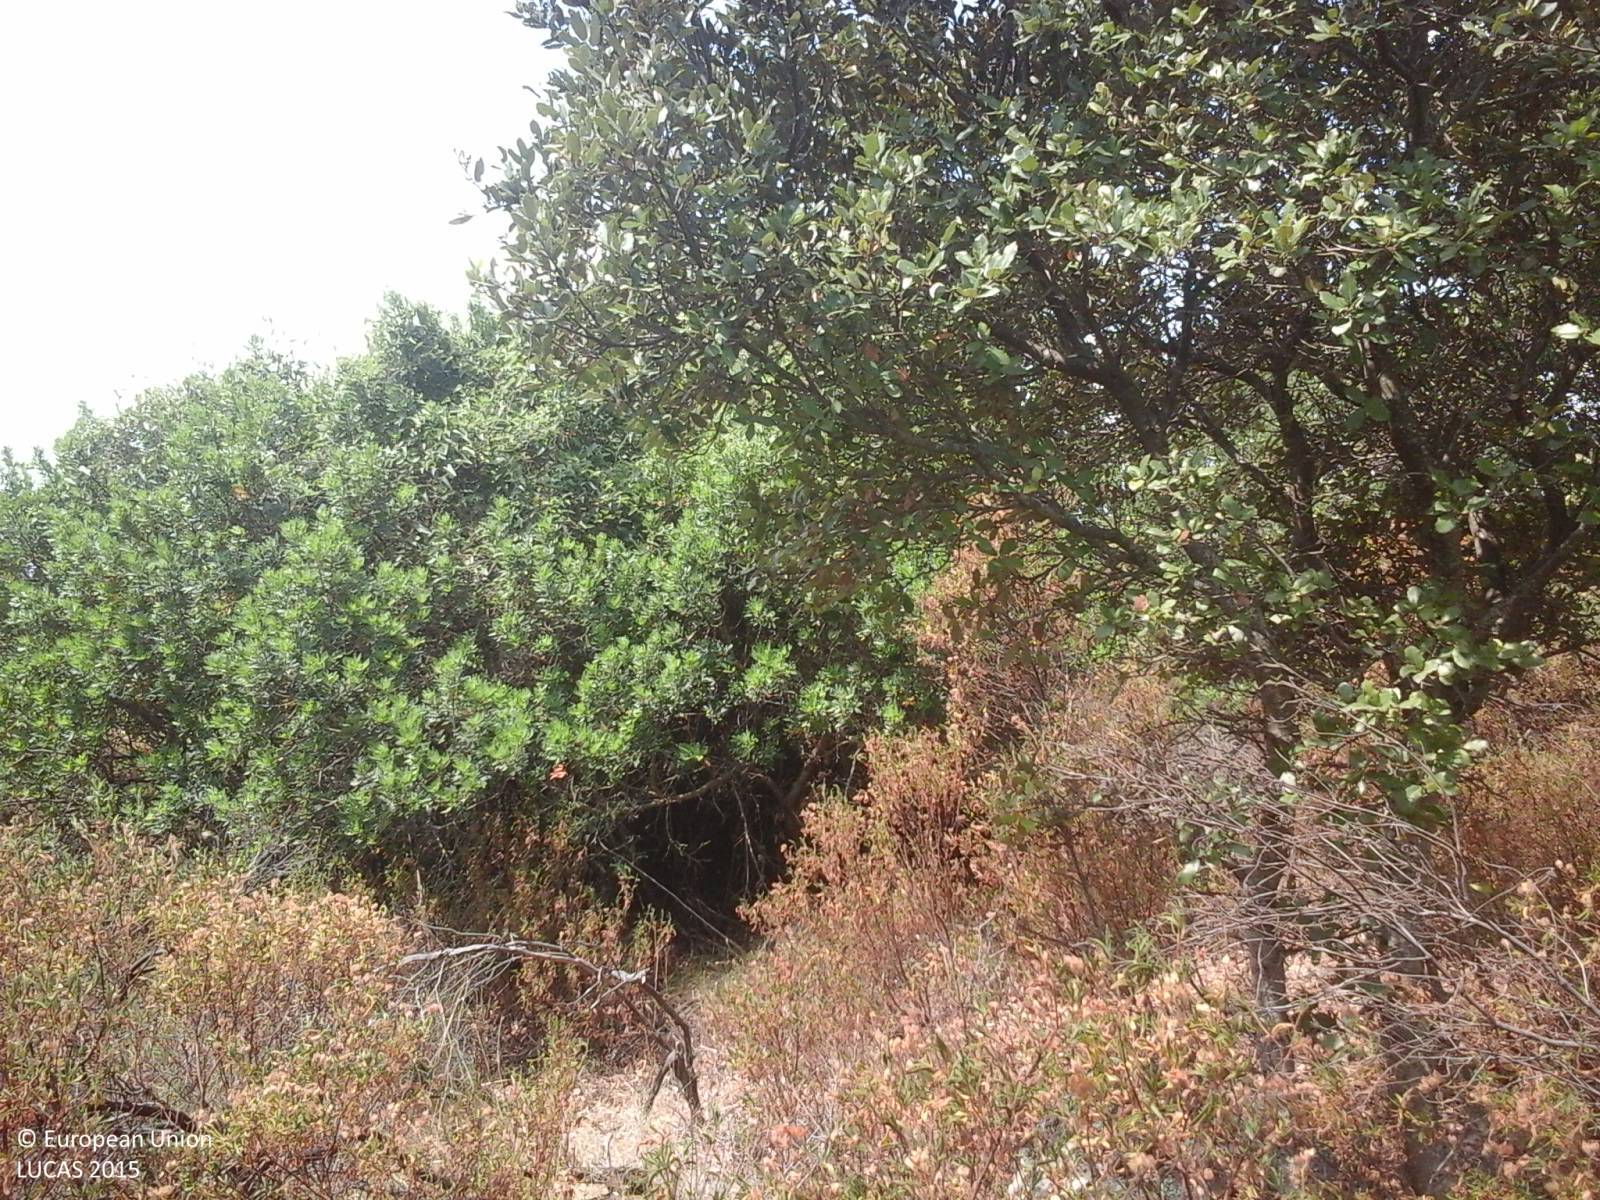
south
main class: Shrubland
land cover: Shrubland with sparse tree cover
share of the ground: > 75 %
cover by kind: shrubs 90 %, broadleaved forest trees 5 %, unconsolidated bare surface 5 %
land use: Agriculture (excluding fallow land and kitchen gardens)
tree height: > 5 m
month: July
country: IT
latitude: 40.8088
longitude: 9.4691
